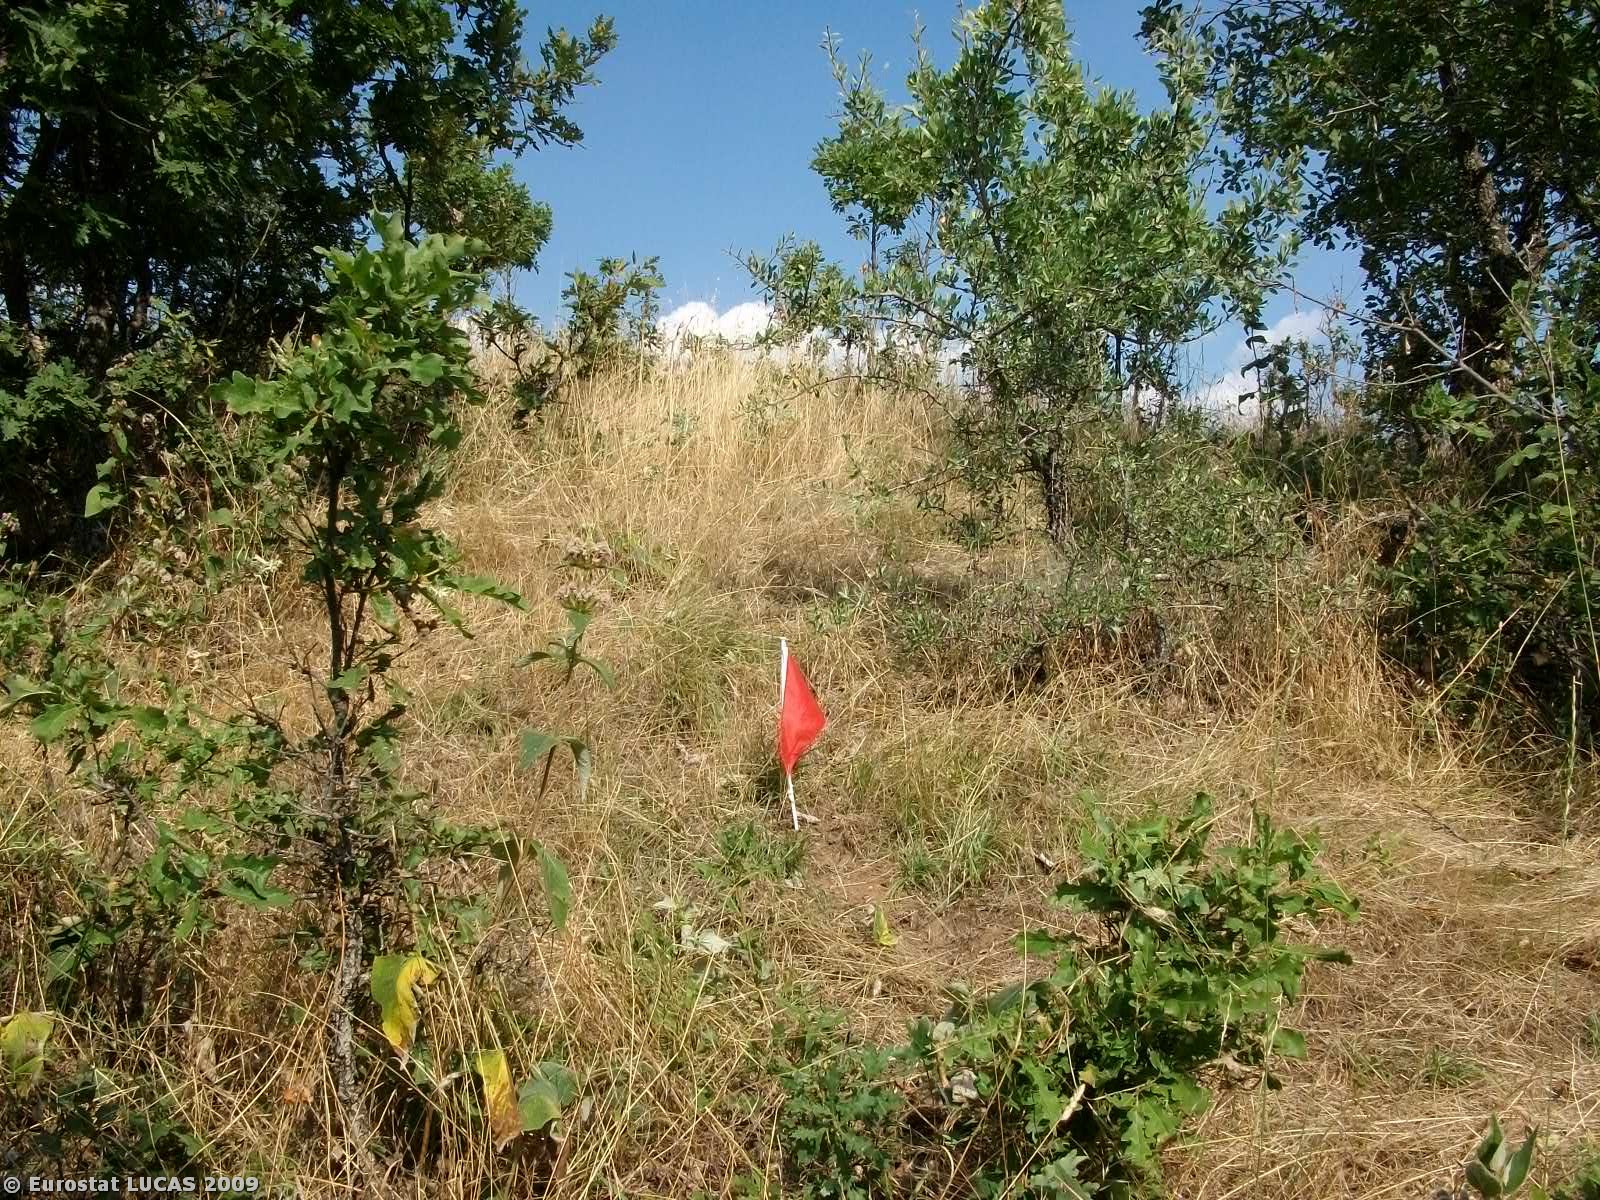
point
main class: Woodland
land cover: Broadleaved woodland
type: thermophilous deciduous forest
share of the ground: 50 - 75 %
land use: Forestry
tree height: > 5 m
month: July
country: GR
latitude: 39.7993
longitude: 21.7233
